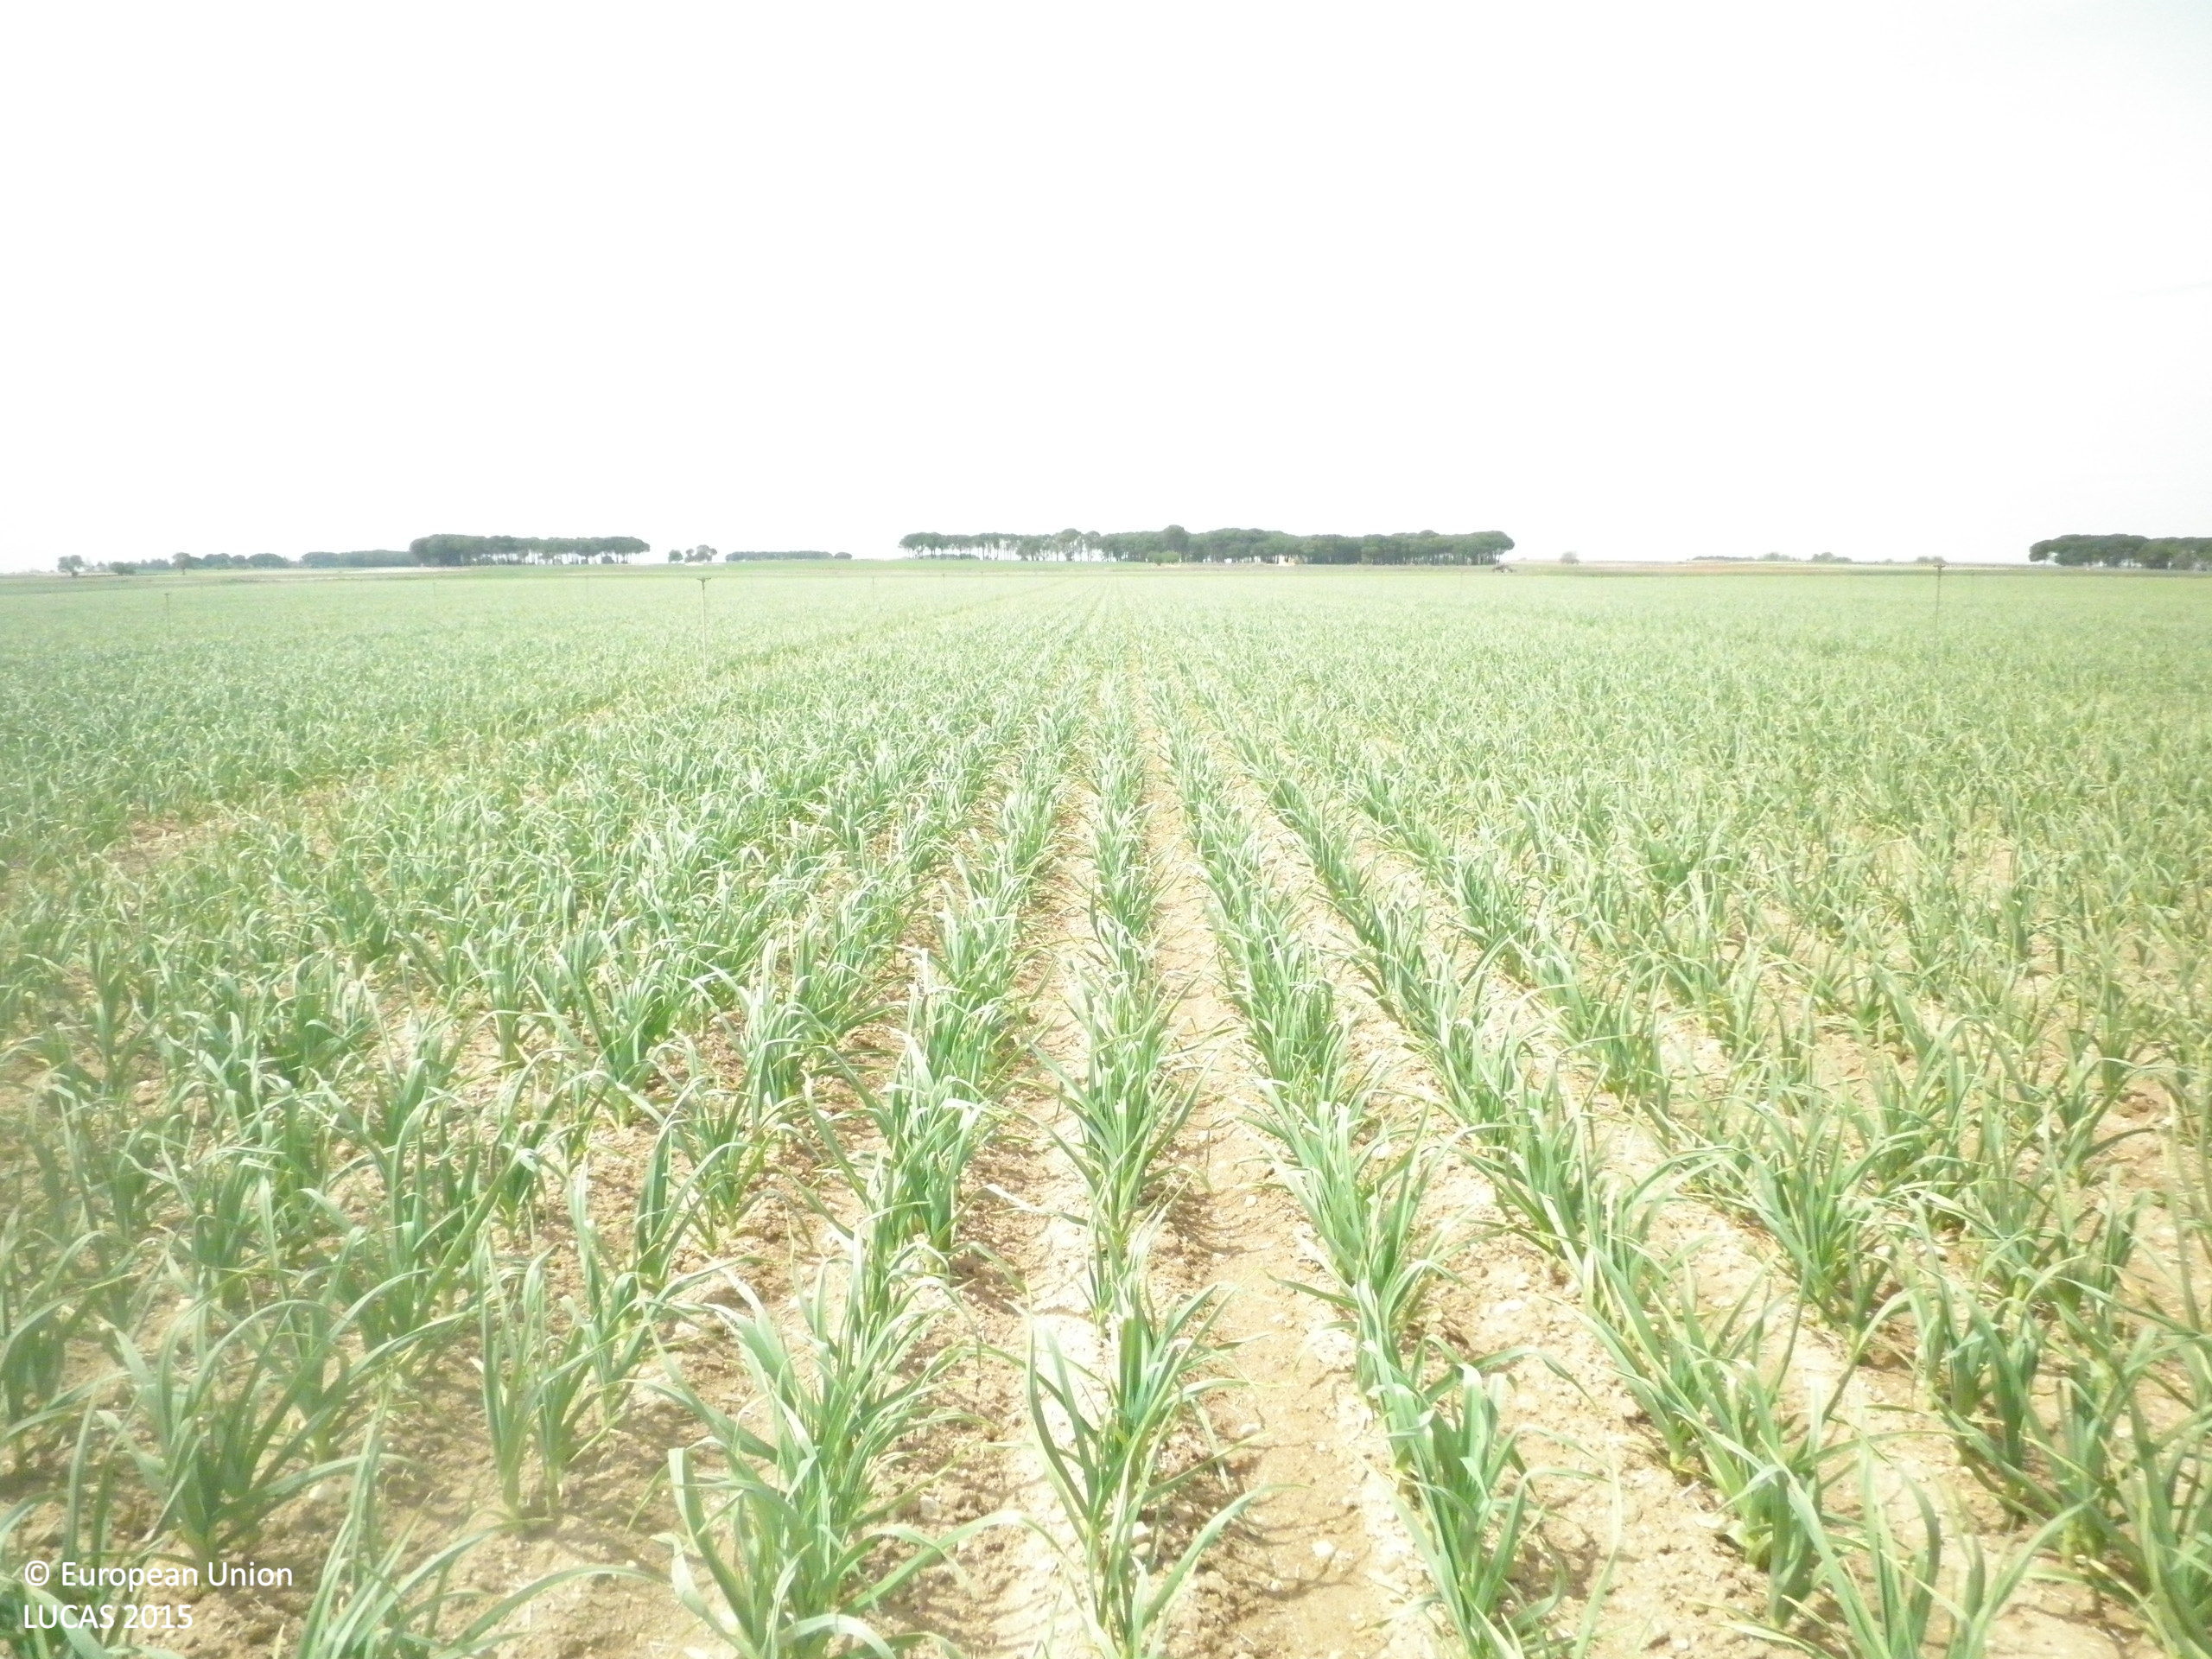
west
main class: Cropland
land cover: Other root crops
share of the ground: 10 - 25 %
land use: Agriculture (excluding fallow land and kitchen gardens)
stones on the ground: < 10 %
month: April
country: ES
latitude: 39.4219
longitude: -2.6859
